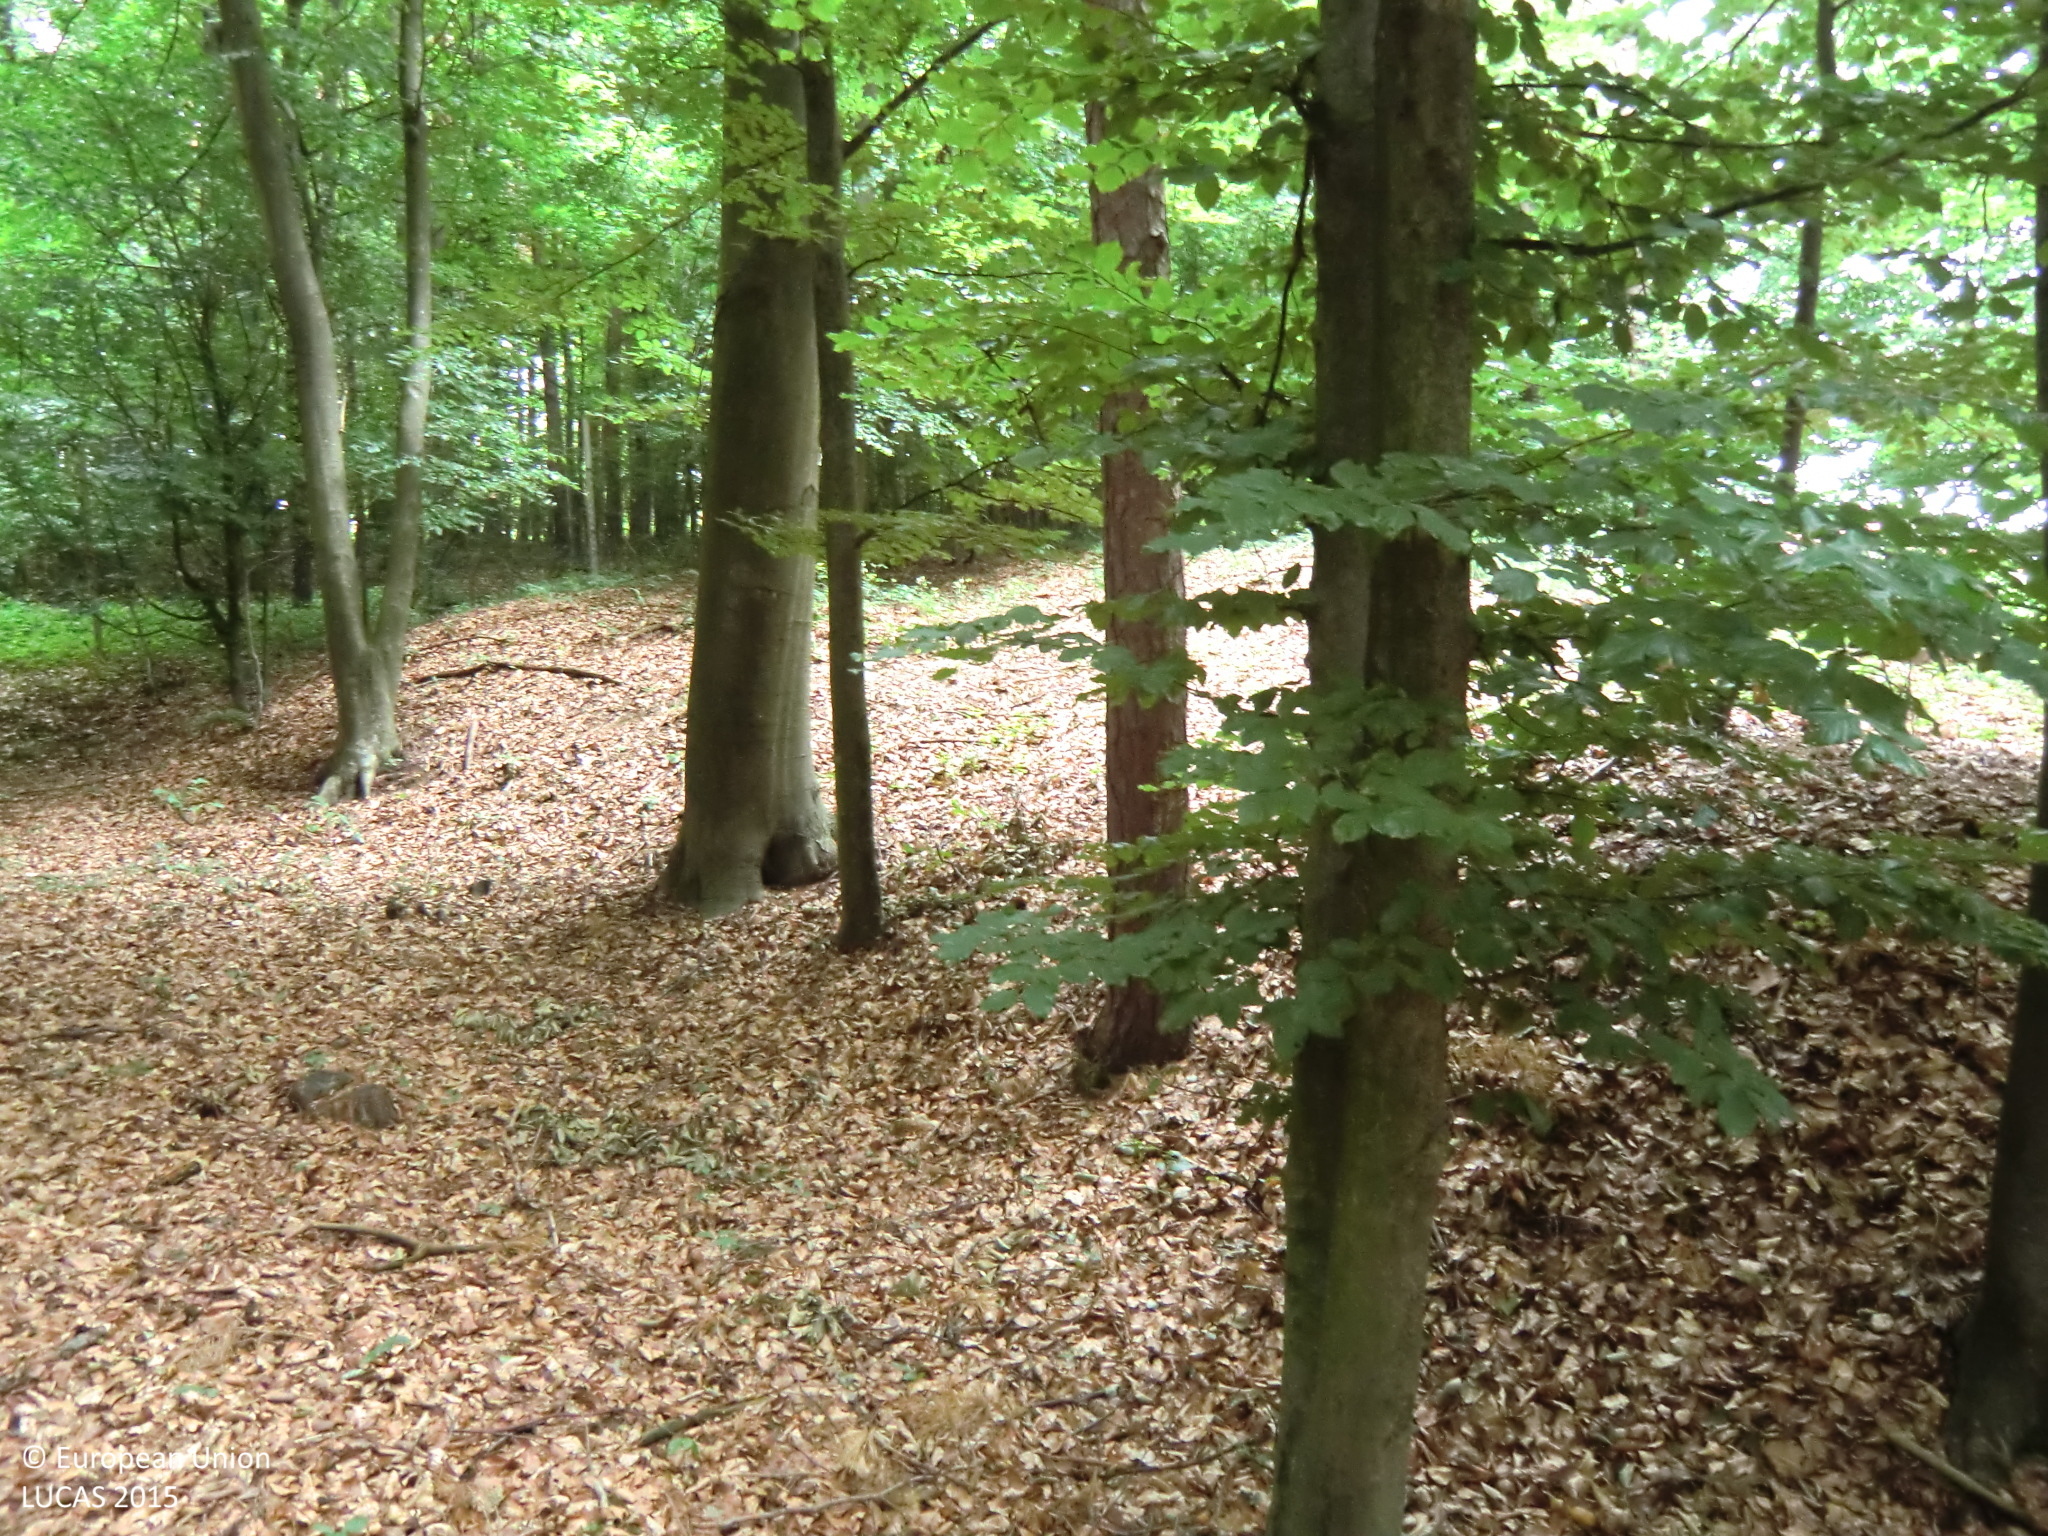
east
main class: Woodland
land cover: Pine dominated mixed woodland
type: hemiboreal forest and nemoral coniferous forest and mixed broadleaved-coniferous forest
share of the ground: > 75 %
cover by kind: coniferous forest trees 40 %, broadleaved forest trees 40 %, unconsolidated bare surface 20 %
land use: Forestry
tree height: > 5 m
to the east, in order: Pine dominated mixed woodland; Fences; Broadleaved woodland; Fences; Pine dominated mixed woodland; Grassland without tree/shrub cover; Paved roads, cycling and walking lanes; Grass margins; Fences; Apple fruit; Artificial constructions in urban areas; Grassland without tree/shrub cover; Artificial constructions in urban areas; Grassland with sparse tree/shrub cover; Artificial constructions in urban areas
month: June
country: AT
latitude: 47.2652
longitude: 16.0152
